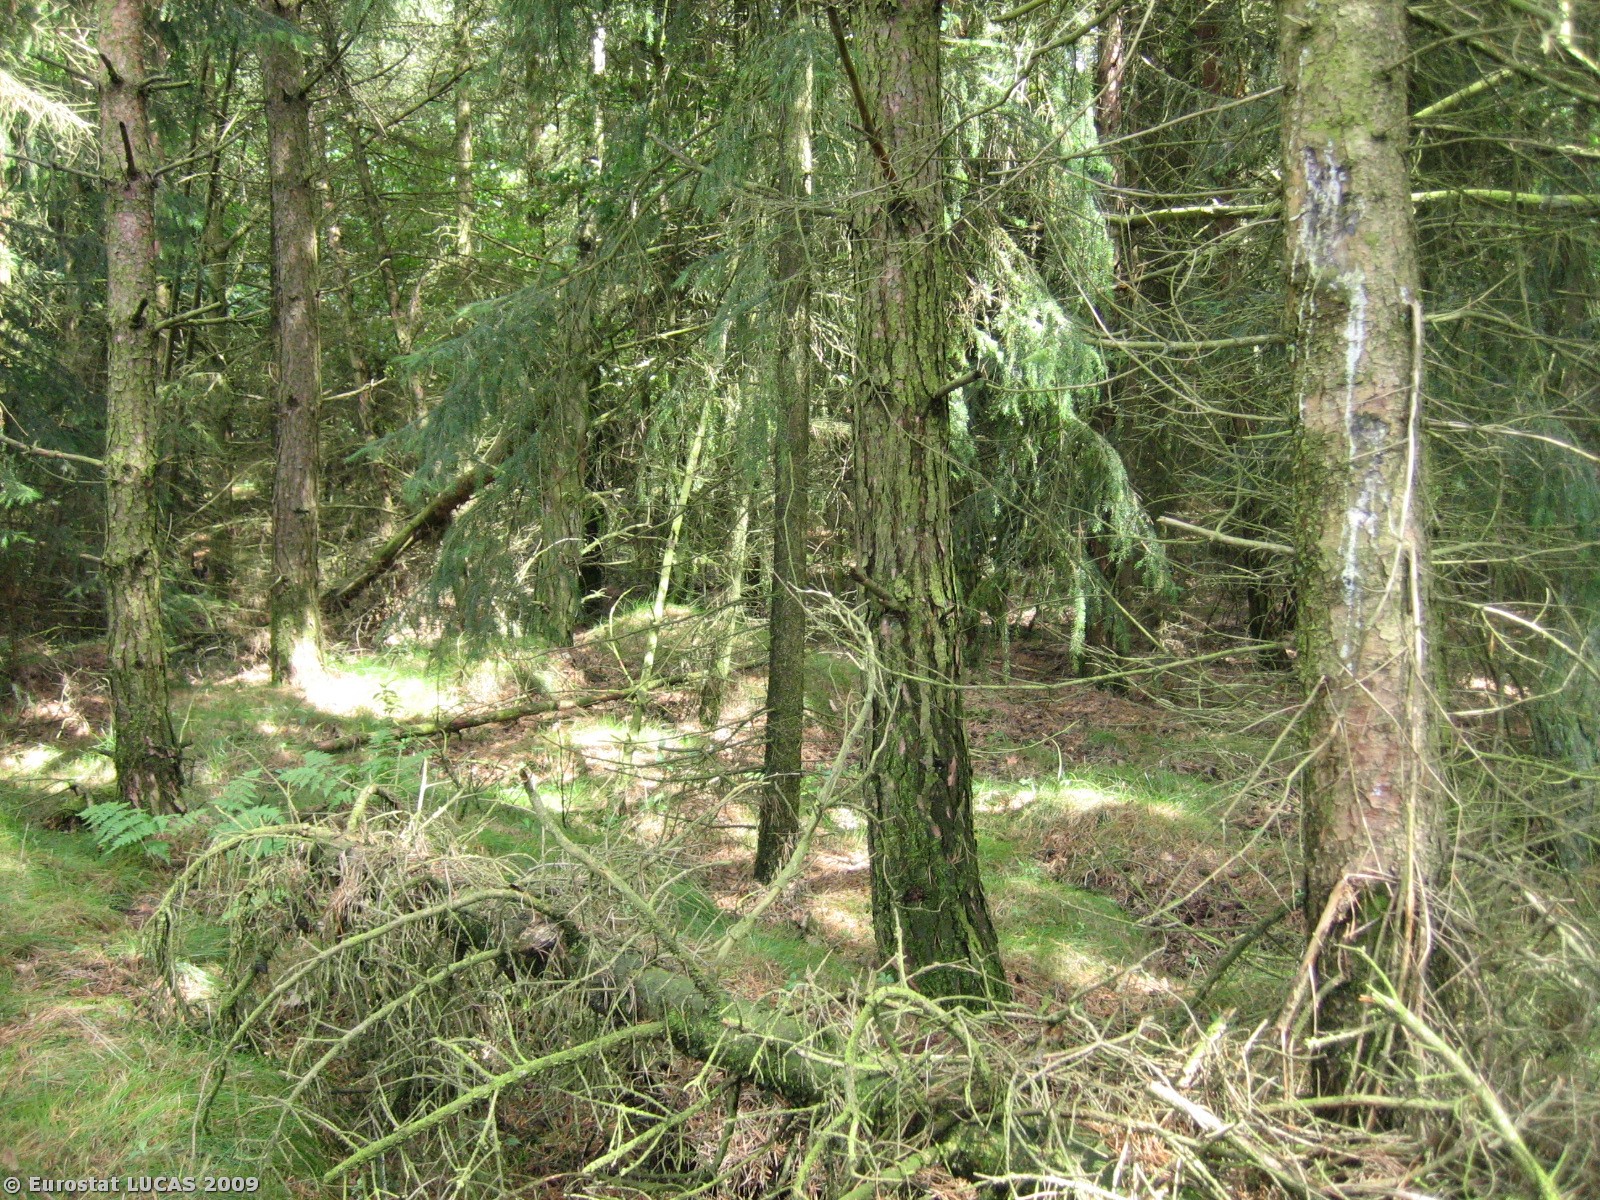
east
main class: Woodland
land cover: Coniferous woodland
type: hemiboreal forest and nemoral coniferous forest and mixed broadleaved-coniferous forest
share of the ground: > 75 %
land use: Forestry
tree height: > 5 m
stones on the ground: < 10 %
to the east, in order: Coniferous woodland; Grassland with sparse tree/shrub cover; Coniferous woodland; Grass margins; Tracks; Grass margins; Coniferous woodland
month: July
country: DK
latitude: 55.6786
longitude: 8.7767
